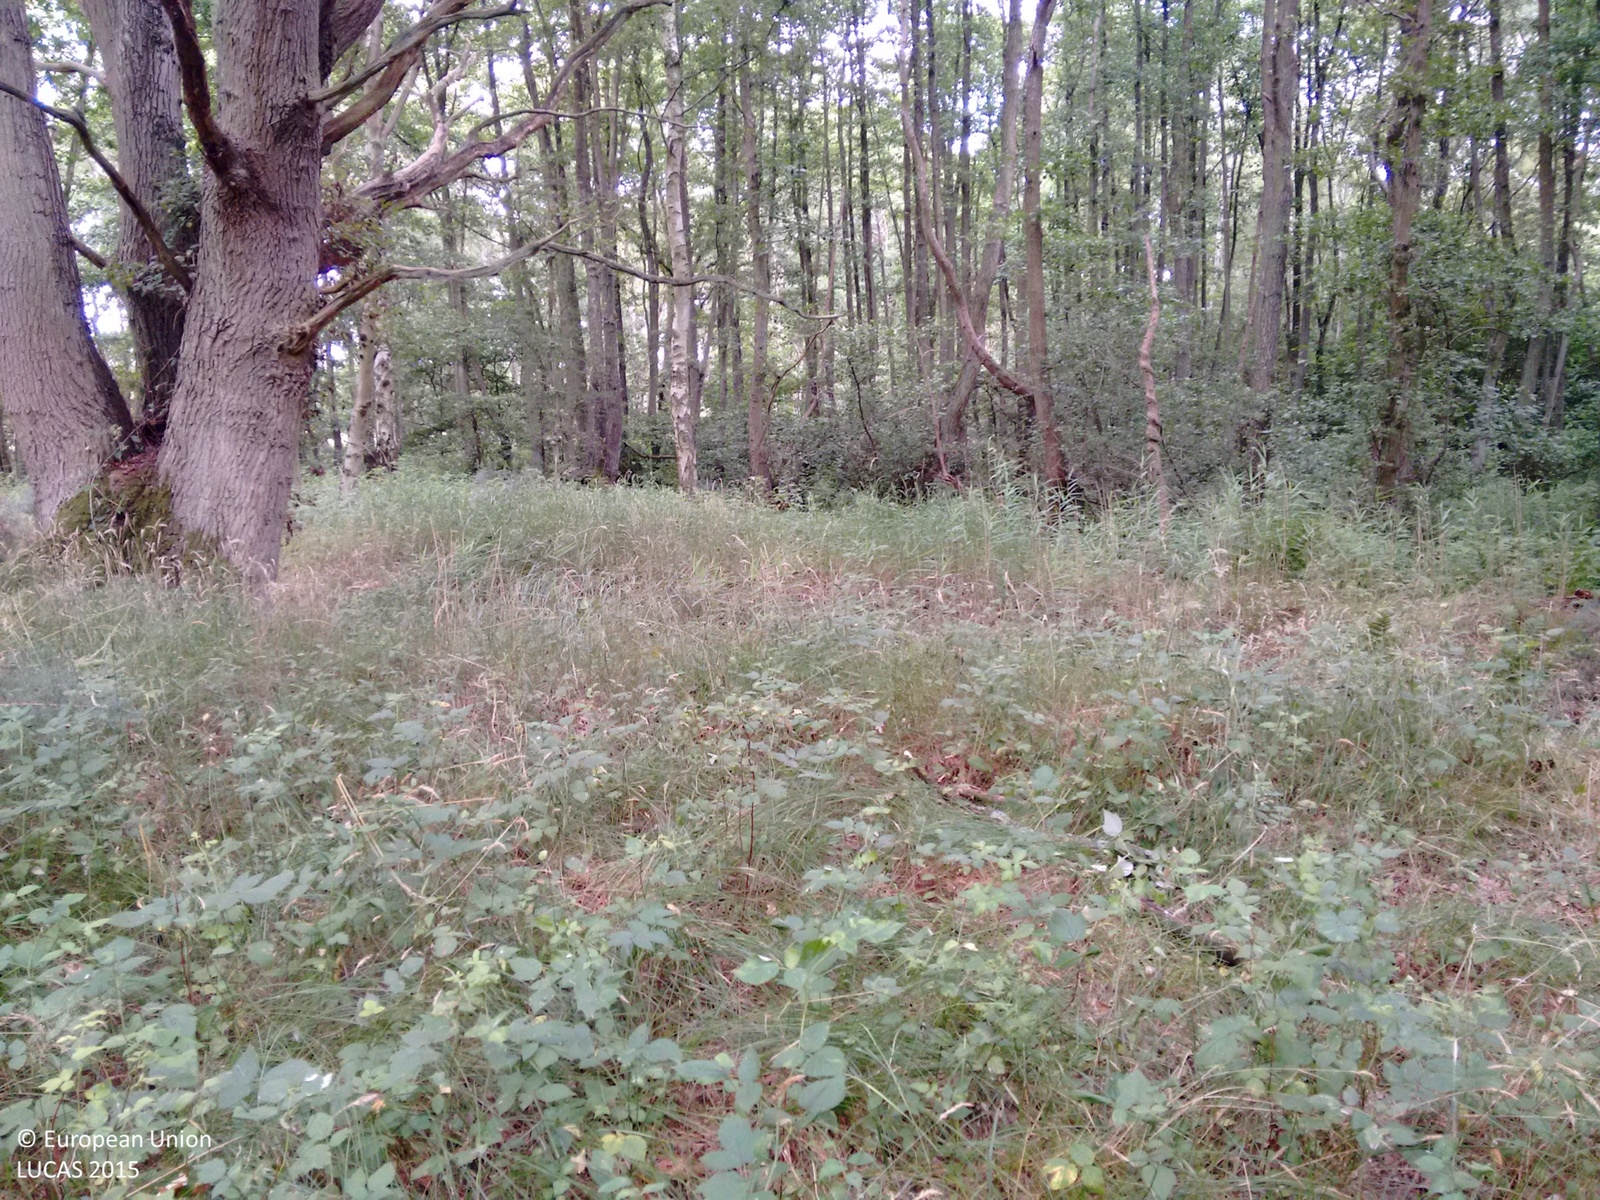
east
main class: Woodland
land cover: Broadleaved woodland
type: mesophytic deciduous forest
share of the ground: > 75 %
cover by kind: broadleaved forest trees 100 %
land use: Amenities, museums, leisure
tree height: > 5 m
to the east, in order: Broadleaved woodland; Ditches and canals; Broadleaved woodland
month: August
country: GB
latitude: 52.3603
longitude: 0.5307
